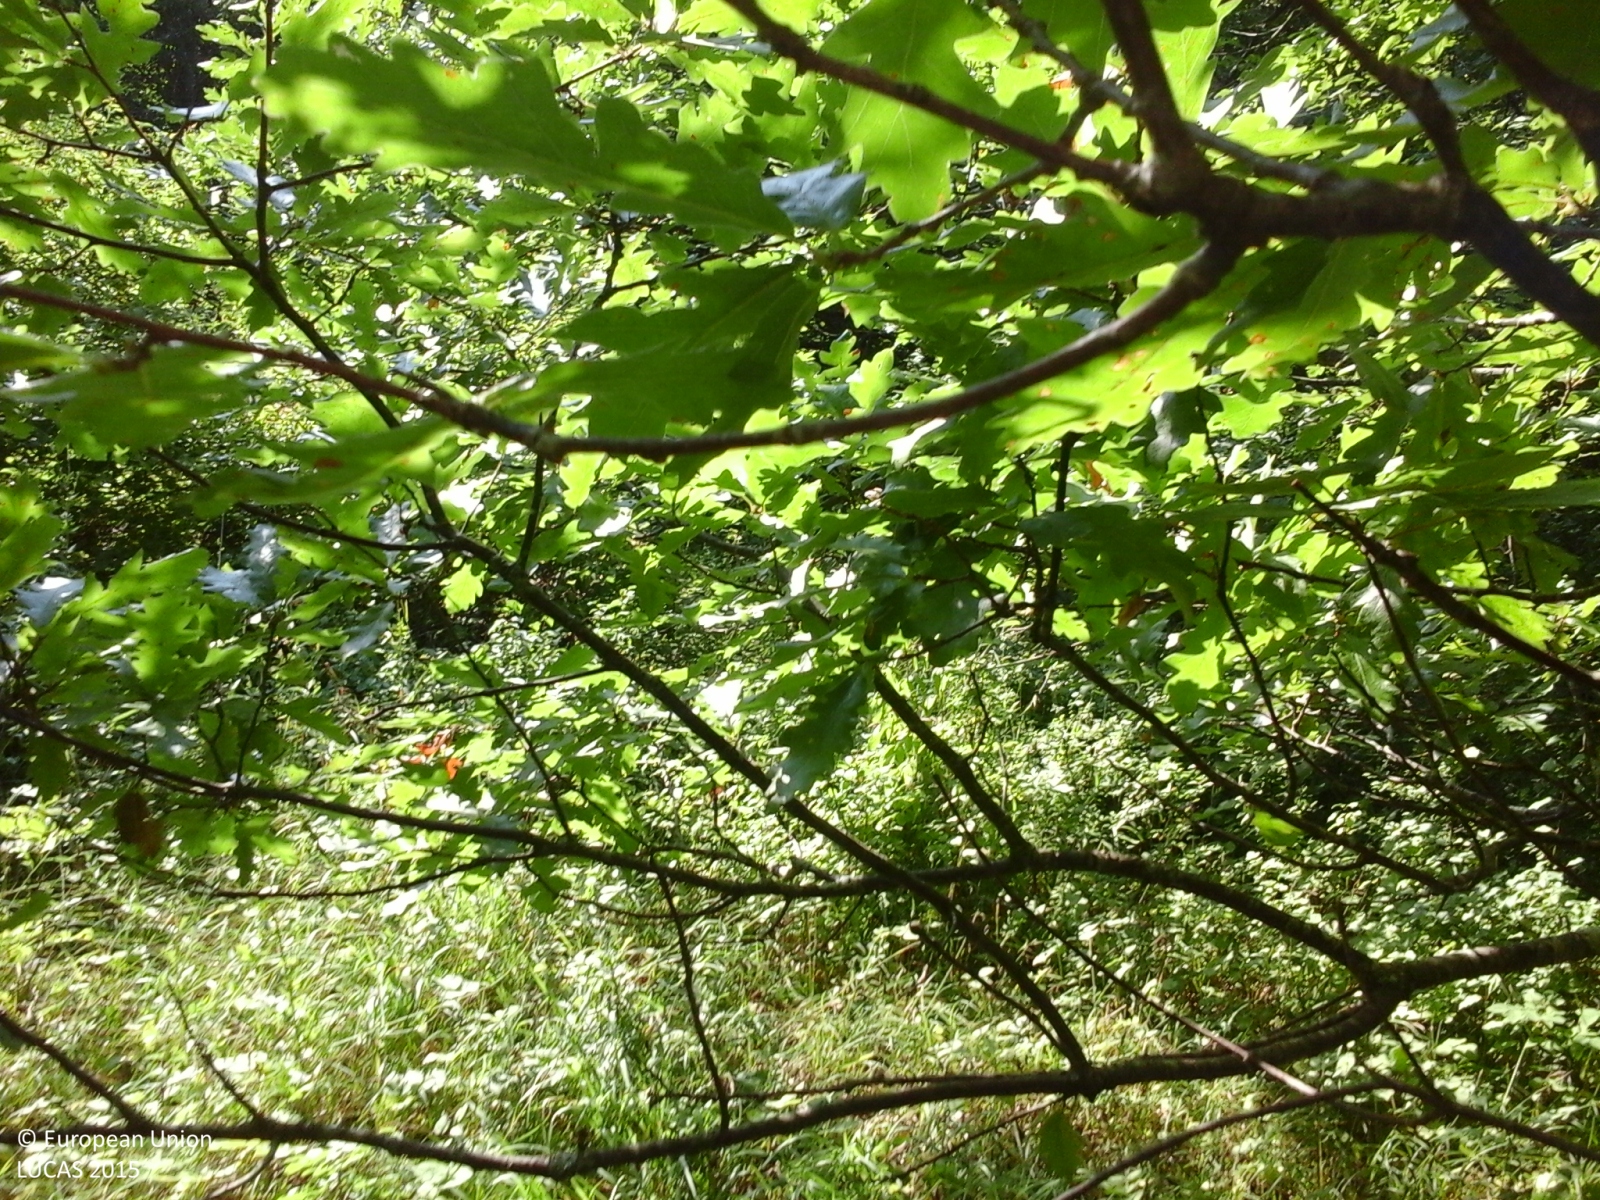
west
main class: Woodland
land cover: Broadleaved woodland
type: thermophilous deciduous forest
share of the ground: > 75 %
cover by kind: broadleaved forest trees 100 %
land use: Forestry
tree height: > 5 m
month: August
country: IT
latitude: 43.6204
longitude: 12.3361
